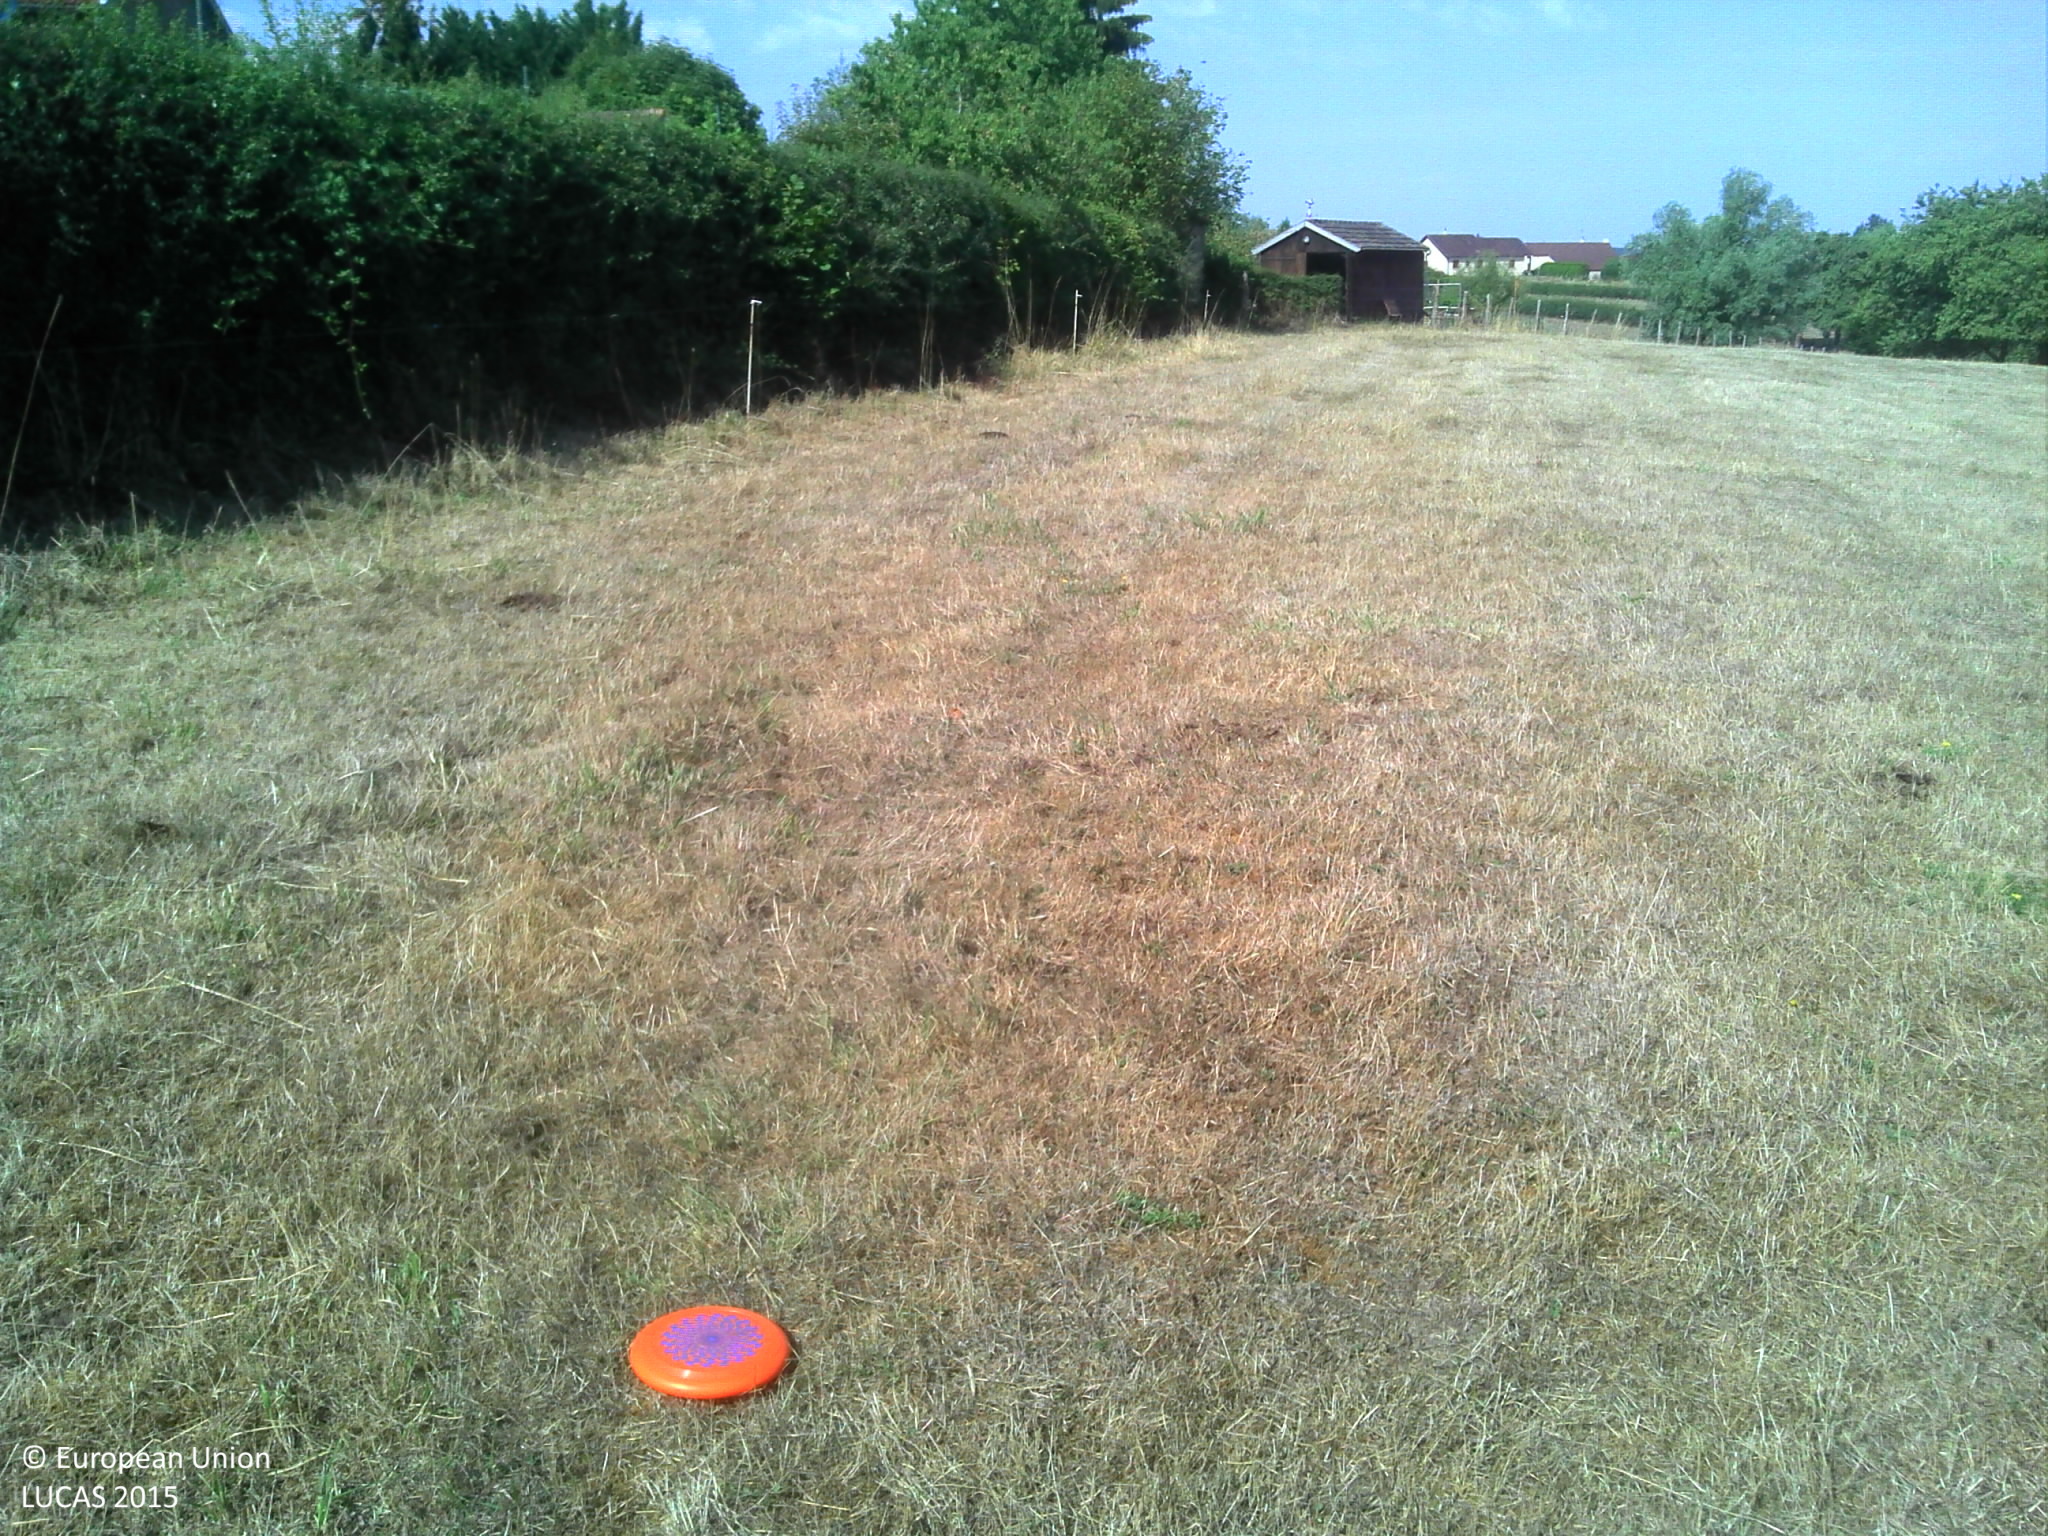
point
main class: Grassland
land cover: Grassland without tree/shrub cover
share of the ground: > 75 %
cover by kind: herbaceous plants 100 %
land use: Agriculture (excluding fallow land and kitchen gardens)
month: August
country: FR
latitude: 46.7094
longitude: 4.3891
